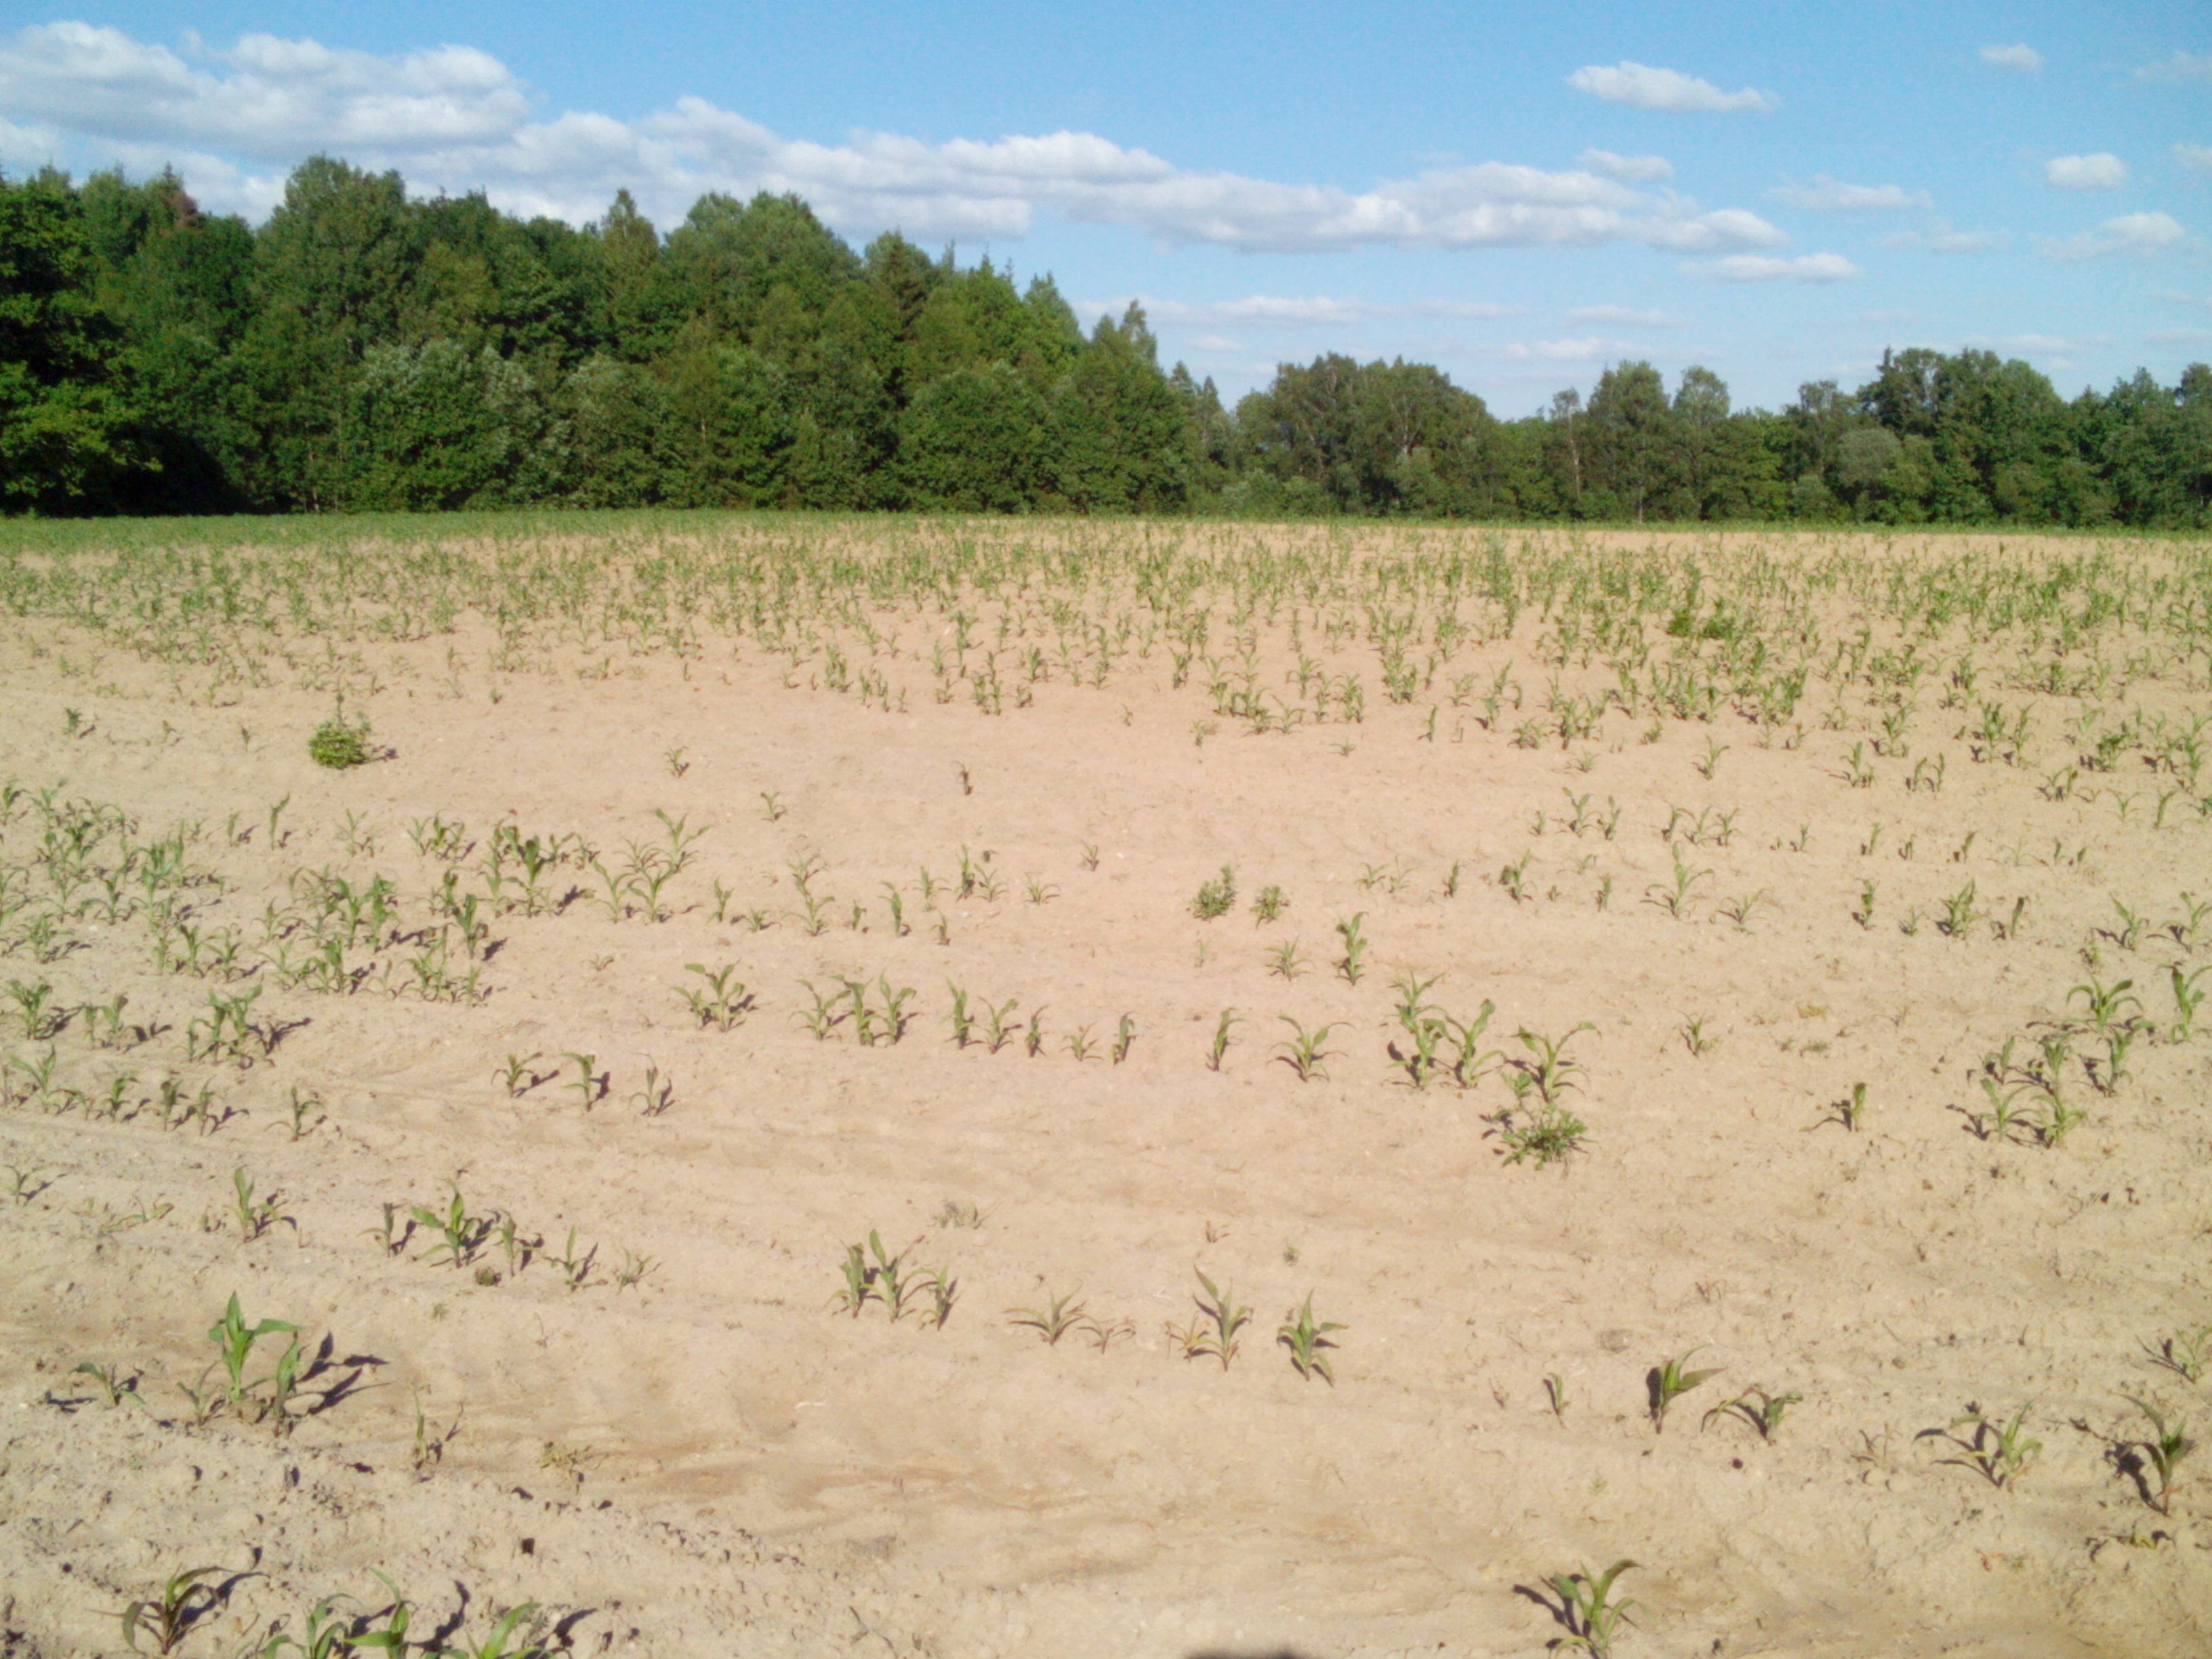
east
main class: Cropland
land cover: Maize
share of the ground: 10 - 25 %
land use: Agriculture (excluding fallow land and kitchen gardens)
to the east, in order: Maize; Broadleaved woodland; Maize
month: July
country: LV
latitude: 56.4381
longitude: 21.8384
